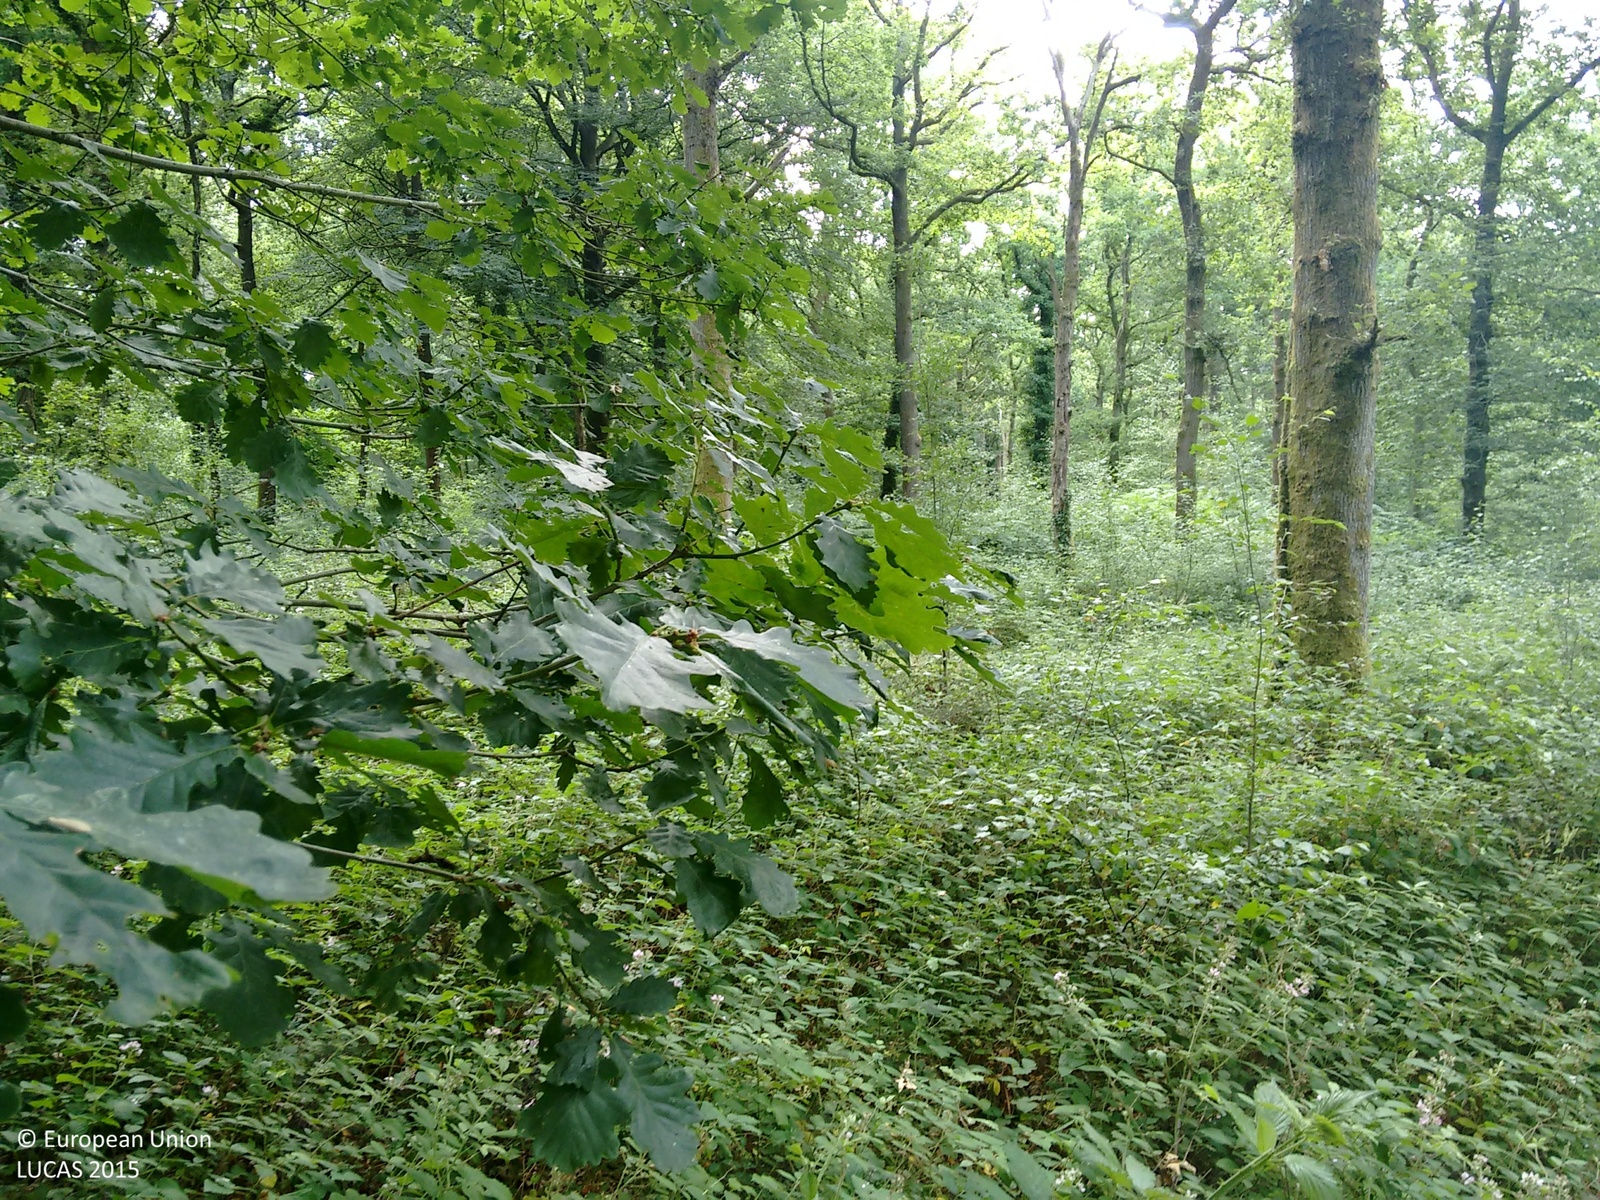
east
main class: Woodland
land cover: Broadleaved woodland
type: acidophilous oak and oak-birch forest
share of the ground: > 75 %
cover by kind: broadleaved forest trees 100 %
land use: Forestry
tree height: > 5 m
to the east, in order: Broadleaved woodland
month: July
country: GB
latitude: 51.0685
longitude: -0.5854
